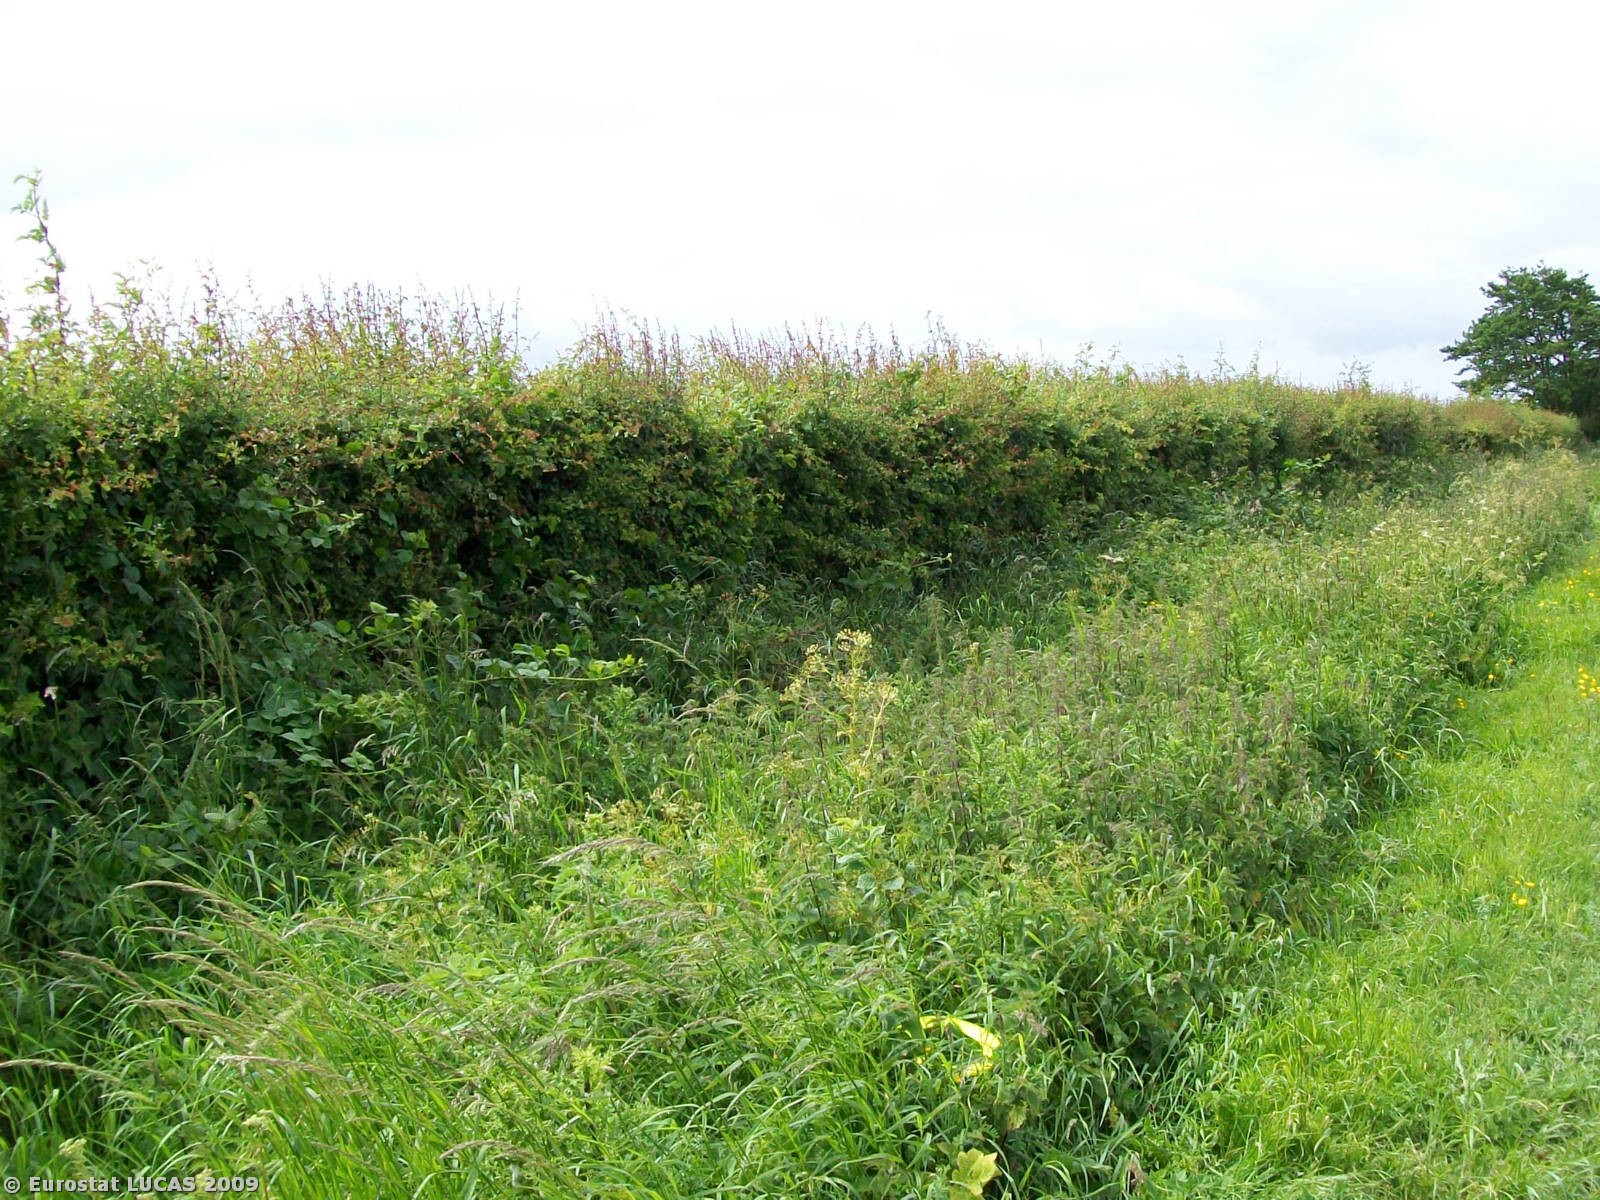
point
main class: Grassland
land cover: Grassland without tree/shrub cover
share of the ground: > 75 %
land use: Road transport
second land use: Unused
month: June
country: GB
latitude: 54.8976
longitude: -3.2207
